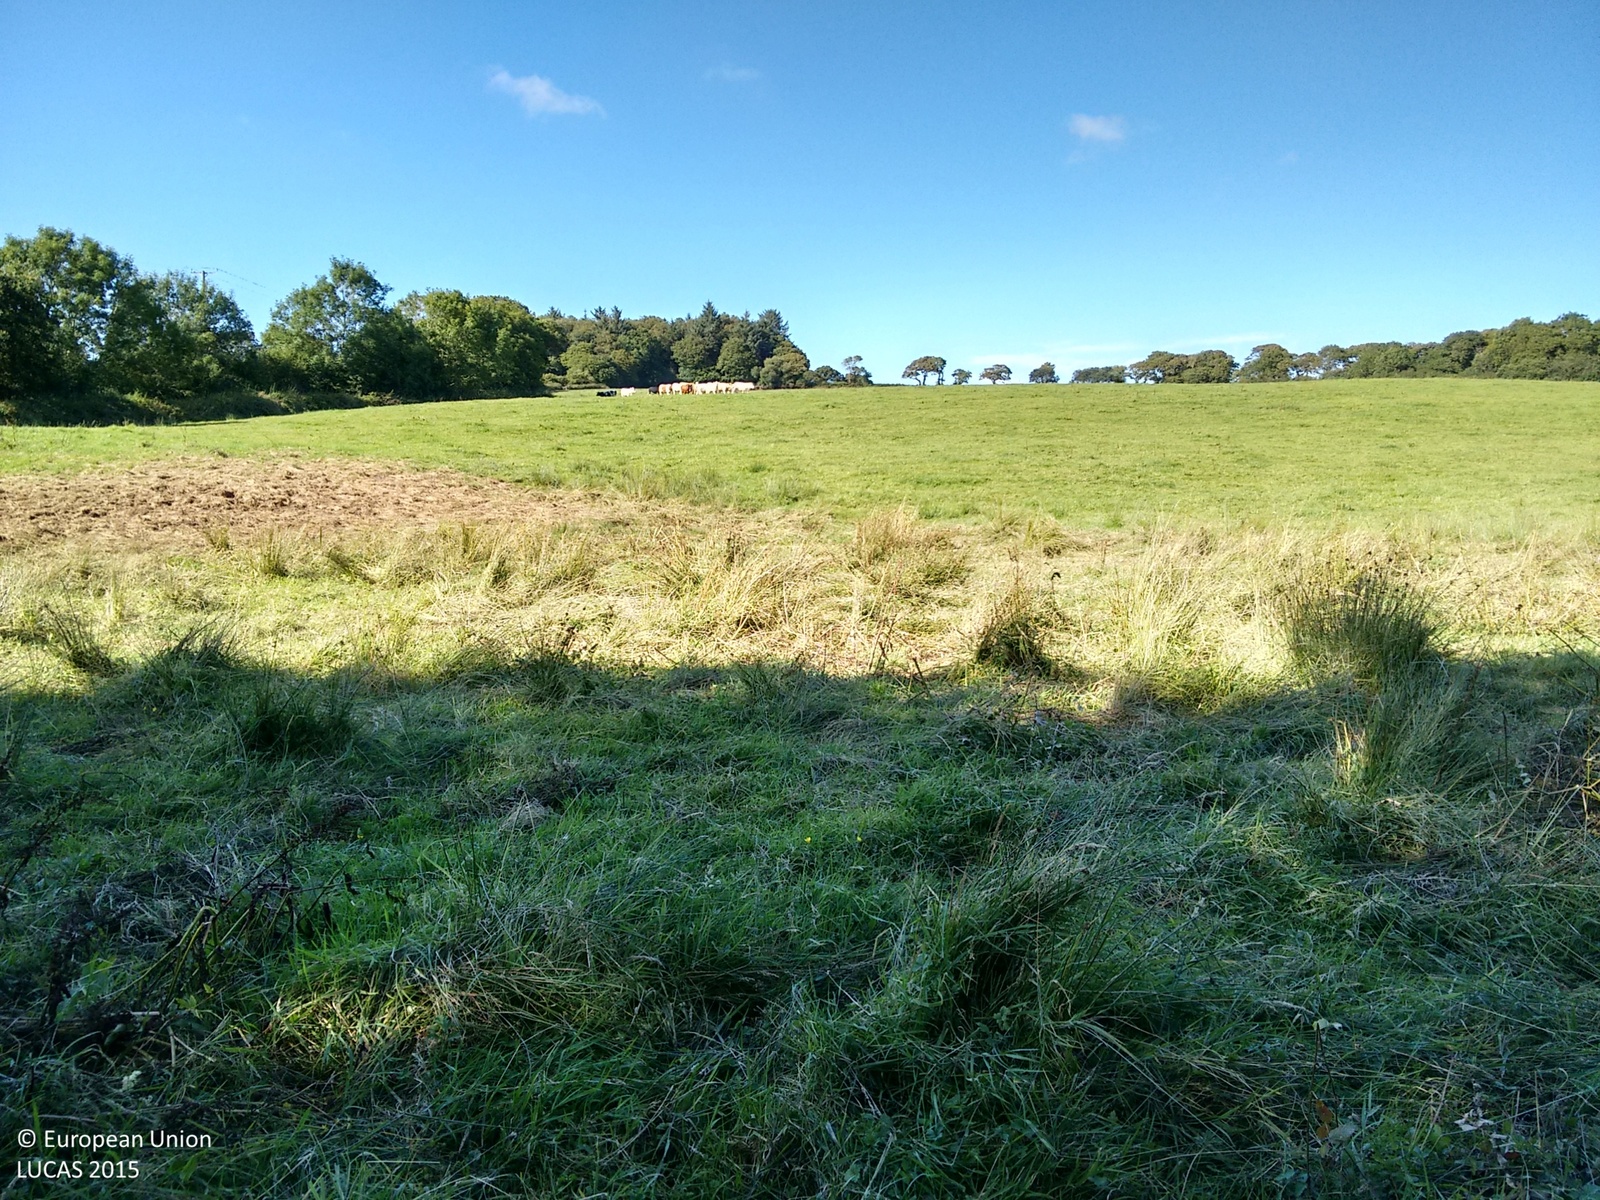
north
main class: Woodland
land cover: Broadleaved woodland
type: mesophytic deciduous forest
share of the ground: > 75 %
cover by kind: broadleaved forest trees 70 %, shrubs 30 %
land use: Semi-natural and natural areas not in use
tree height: > 5 m
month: August
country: GB
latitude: 51.6990
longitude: -4.7981
